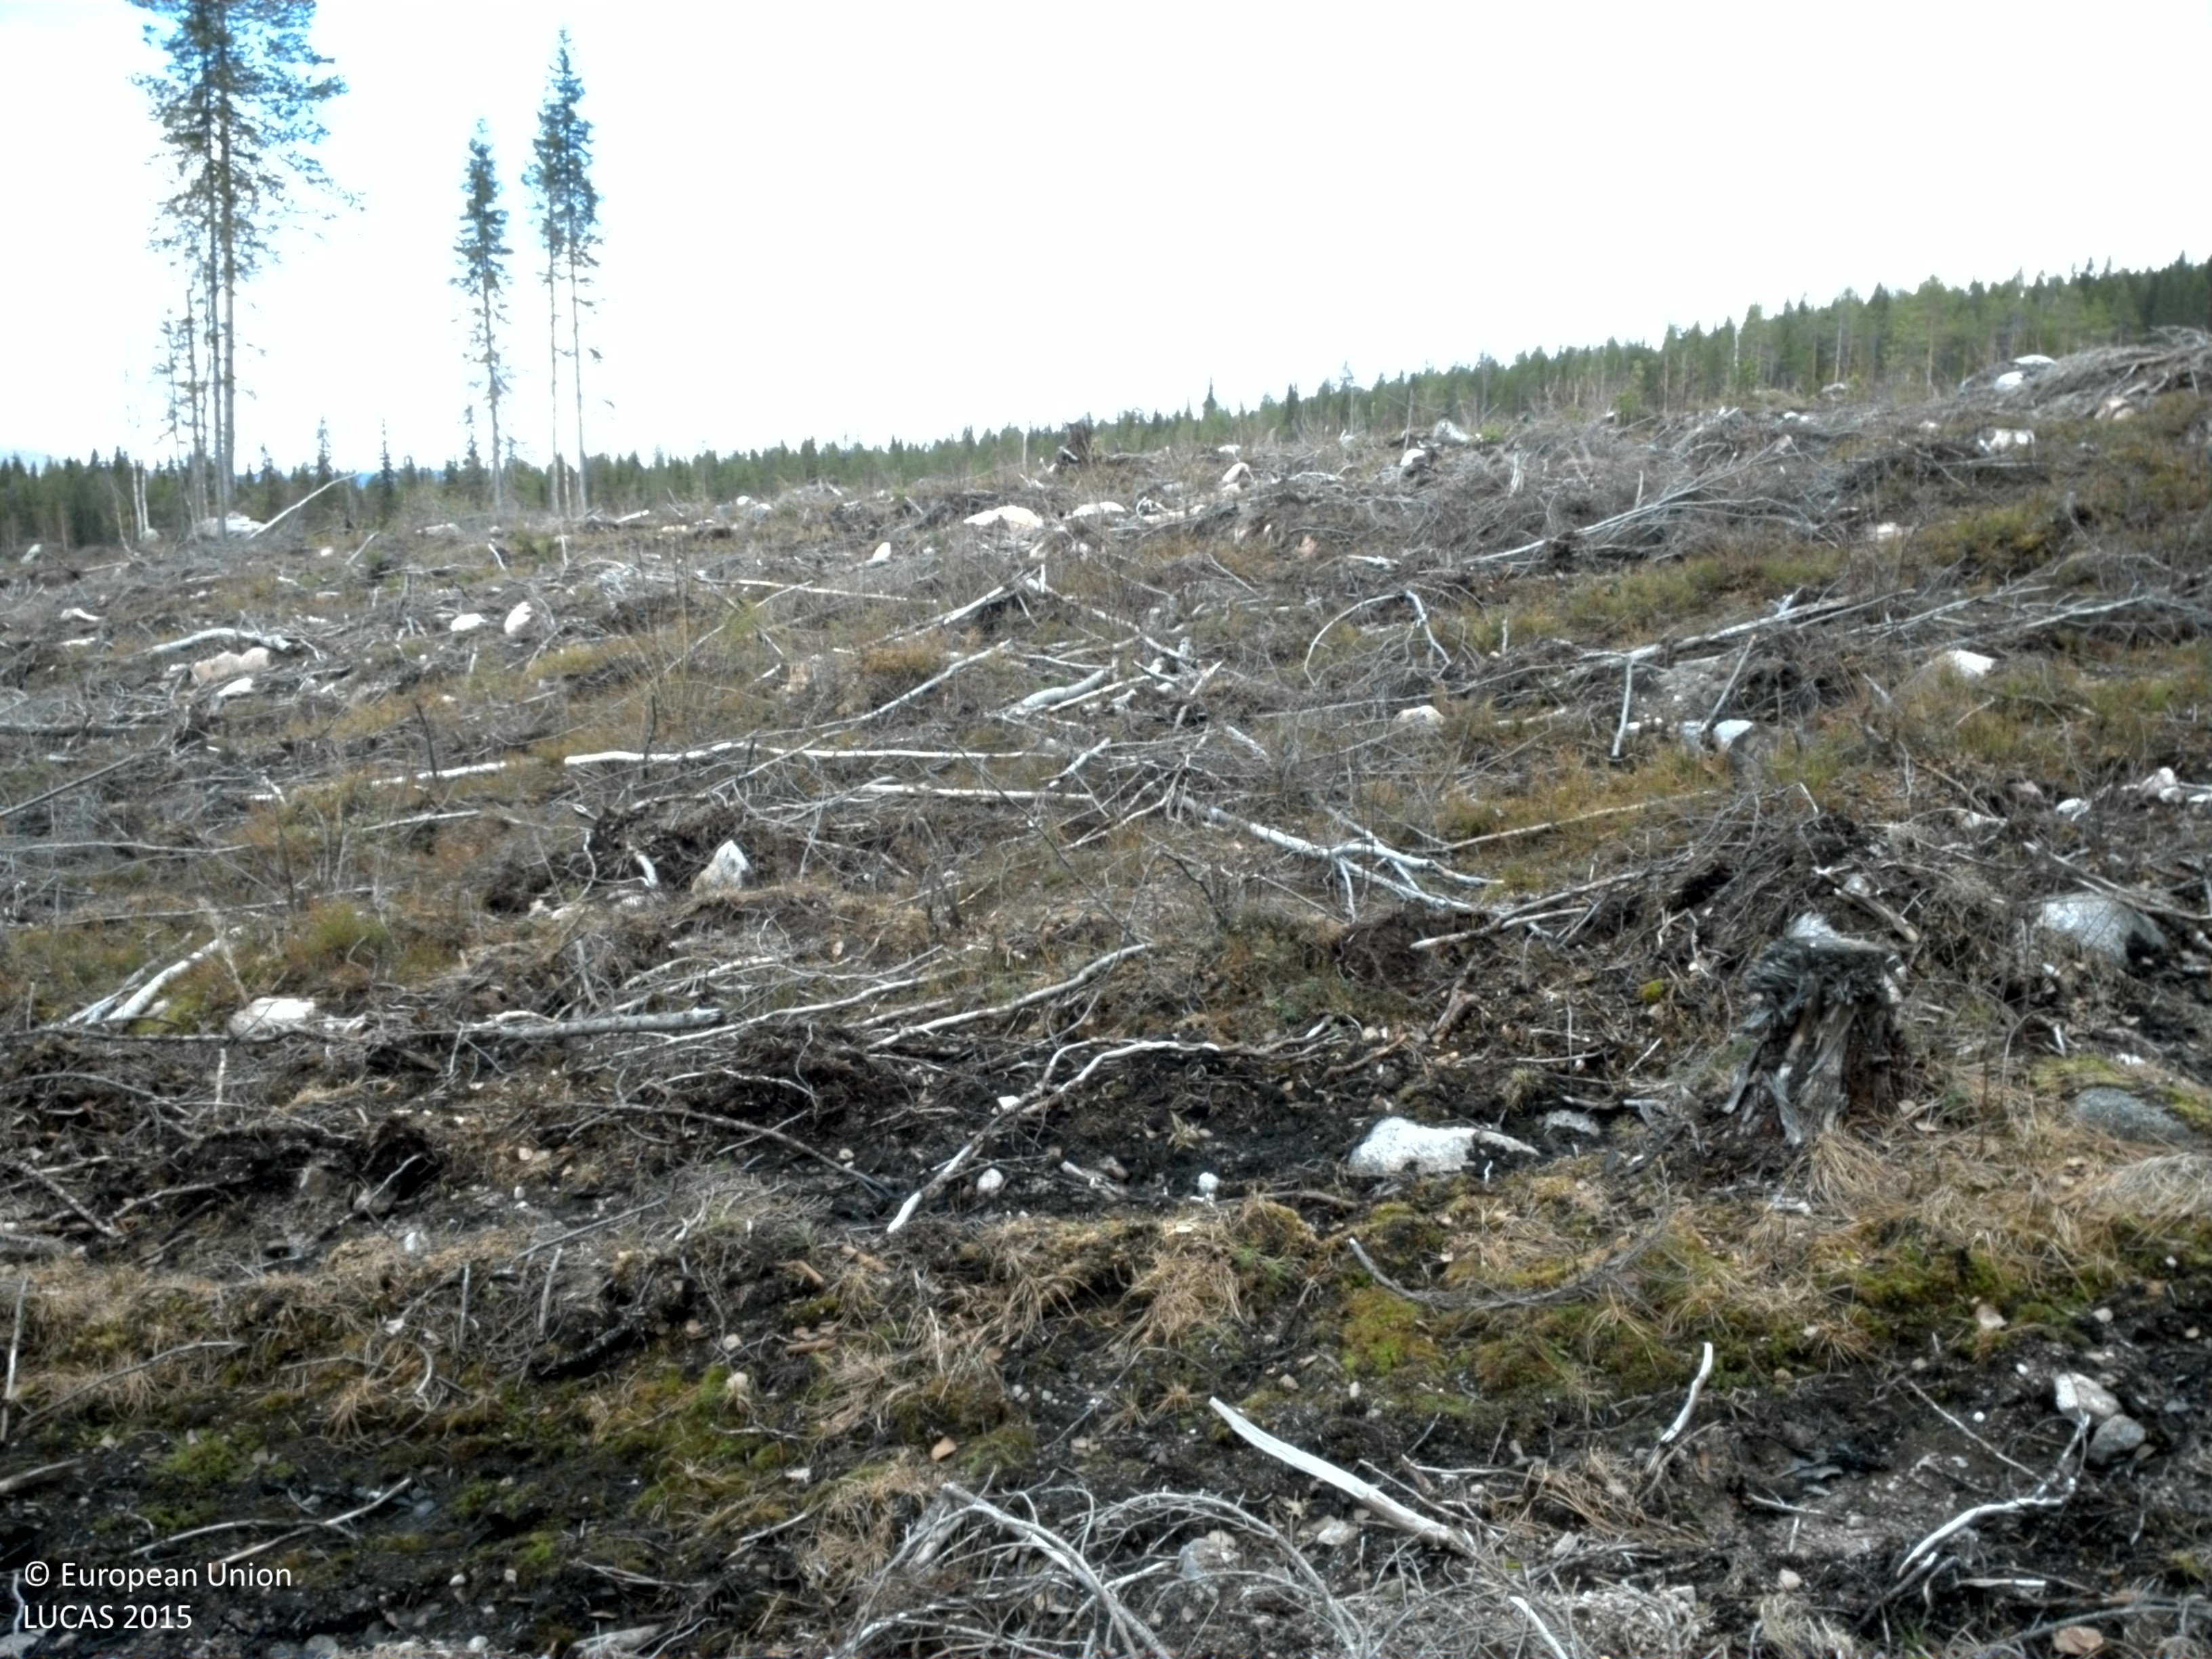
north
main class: Shrubland
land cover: Shrubland with sparse tree cover
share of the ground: 10 - 25 %
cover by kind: shrubs 20 %, unconsolidated bare surface 15 %, broadleaved forest trees 5 %, lichens and mosses 5 %
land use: Forestry
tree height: < 5 m
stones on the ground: 10 - 25 %
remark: Clear cut
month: May
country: SE
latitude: 66.3358
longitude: 23.5395
